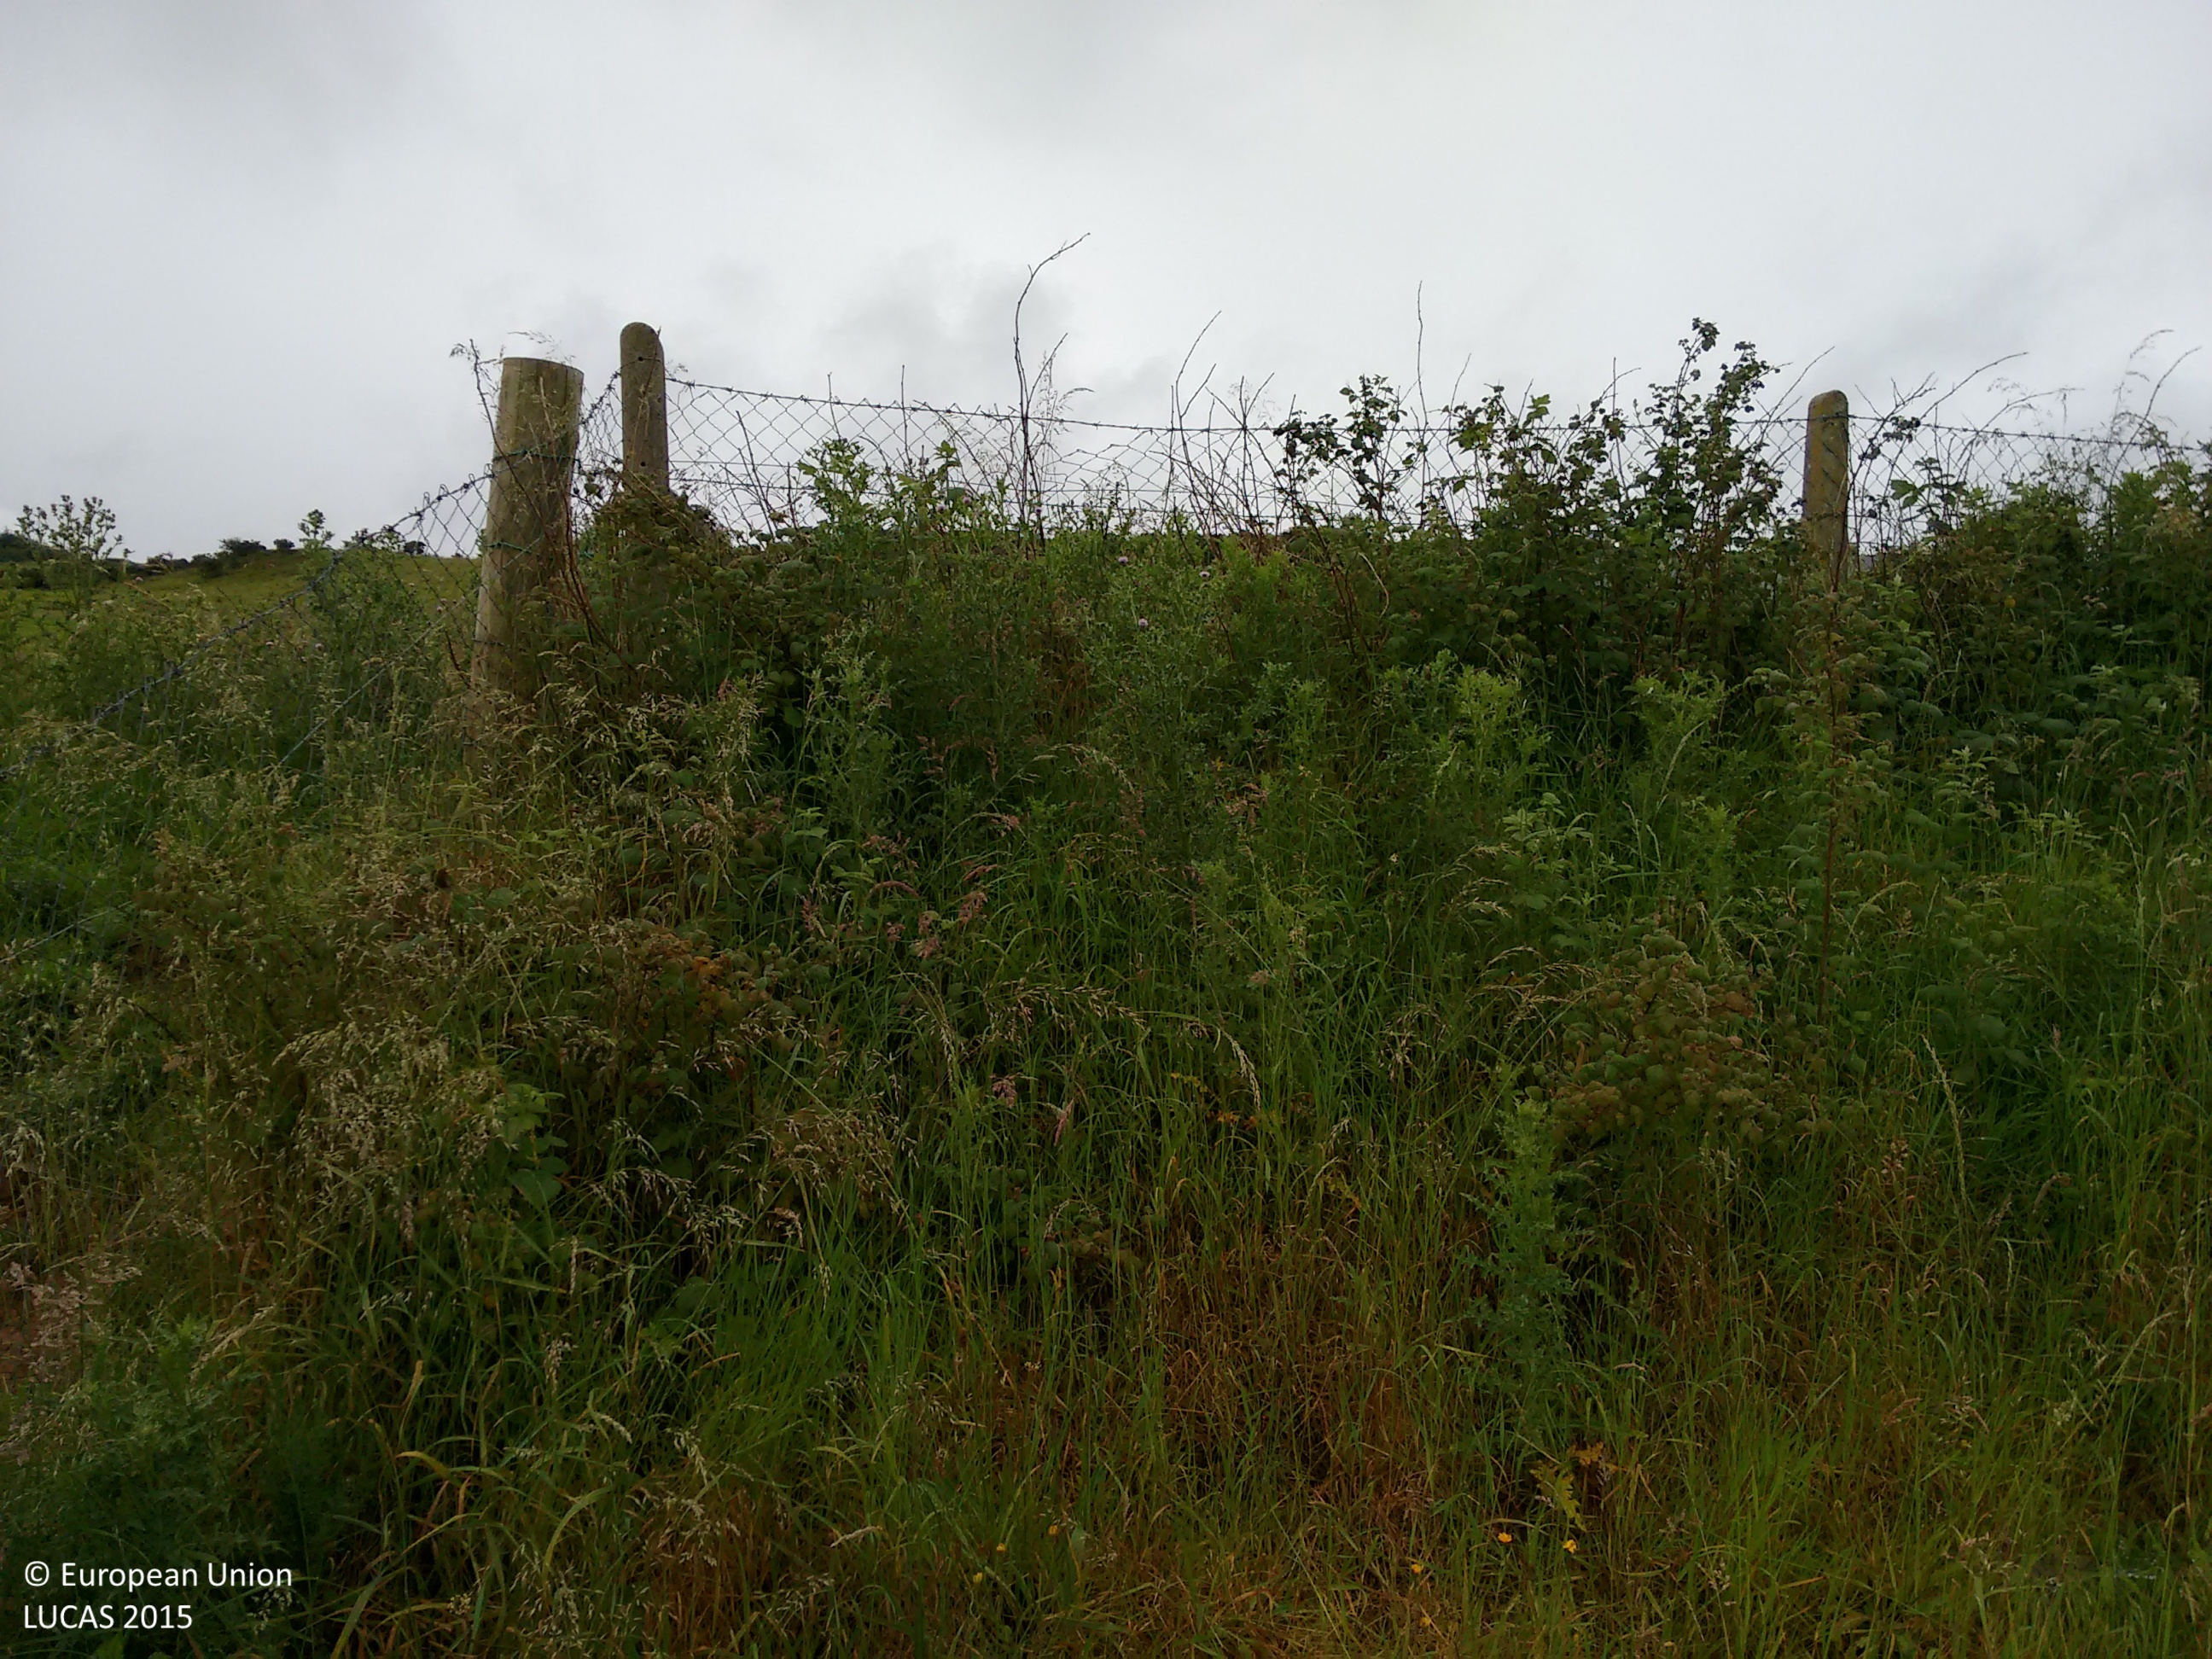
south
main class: Grassland
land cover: Grassland with sparse tree/shrub cover
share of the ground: > 75 %
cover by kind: herbaceous plants 85 %, shrubs 10 %, broadleaved forest trees 5 %
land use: Agriculture (excluding fallow land and kitchen gardens)
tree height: < 5 m
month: July
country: IE
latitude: 52.7998
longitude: -8.6659
